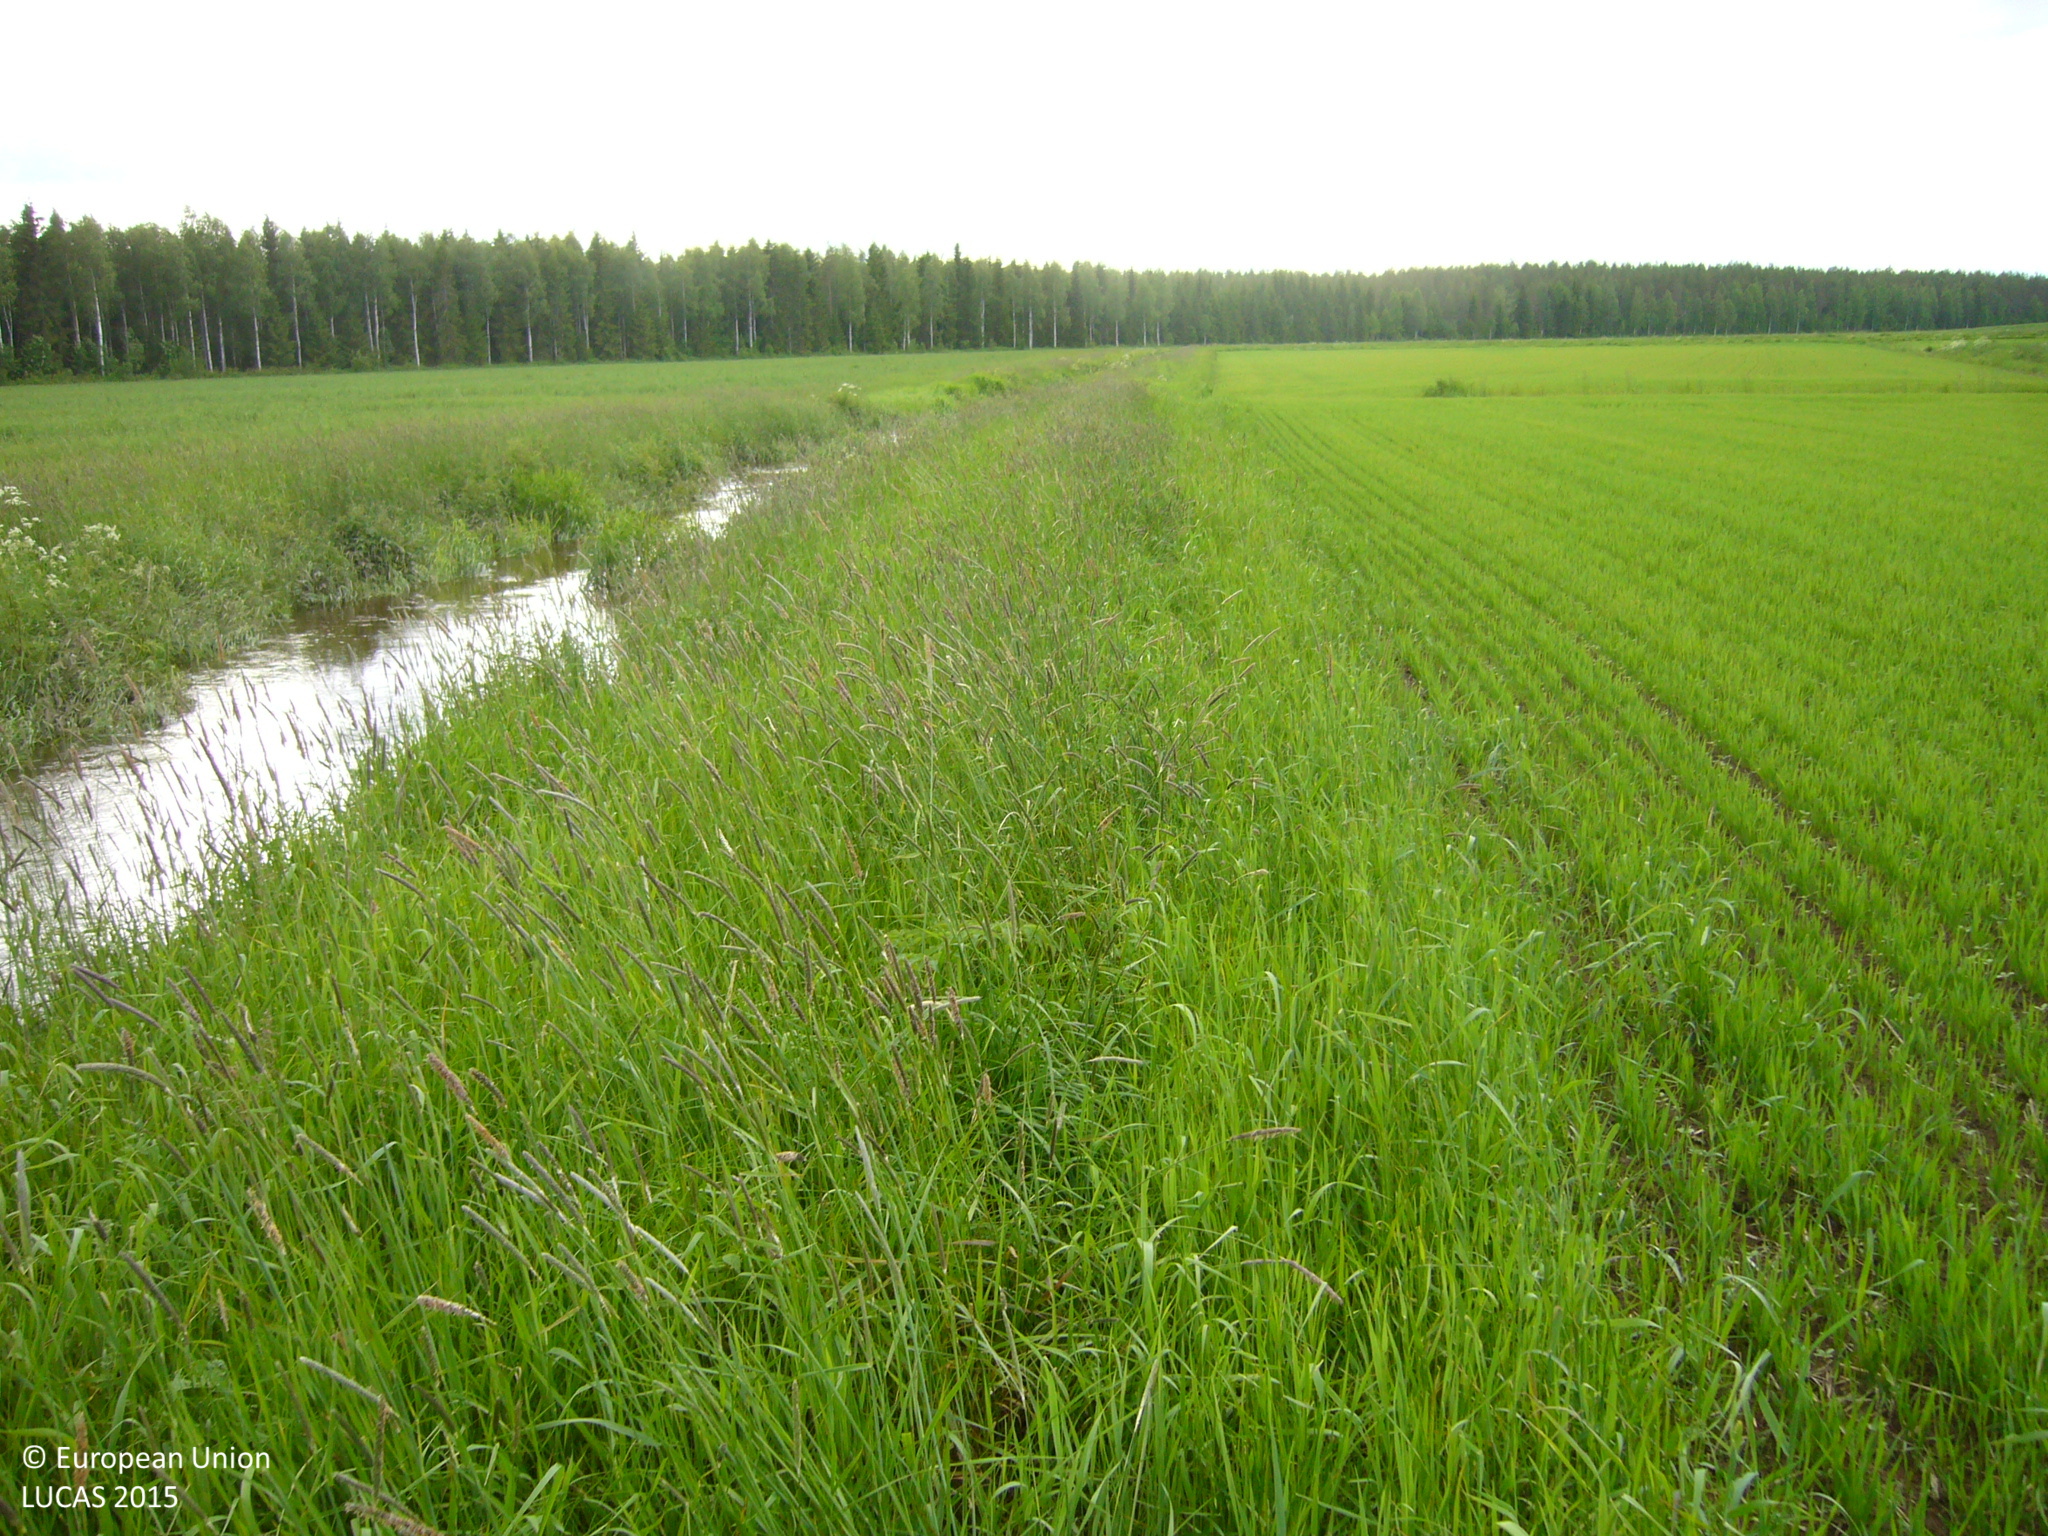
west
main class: Cropland
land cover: Barley
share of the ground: 50 - 75 %
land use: Agriculture (excluding fallow land and kitchen gardens)
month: June
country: FI
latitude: 63.7409
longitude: 26.3885
